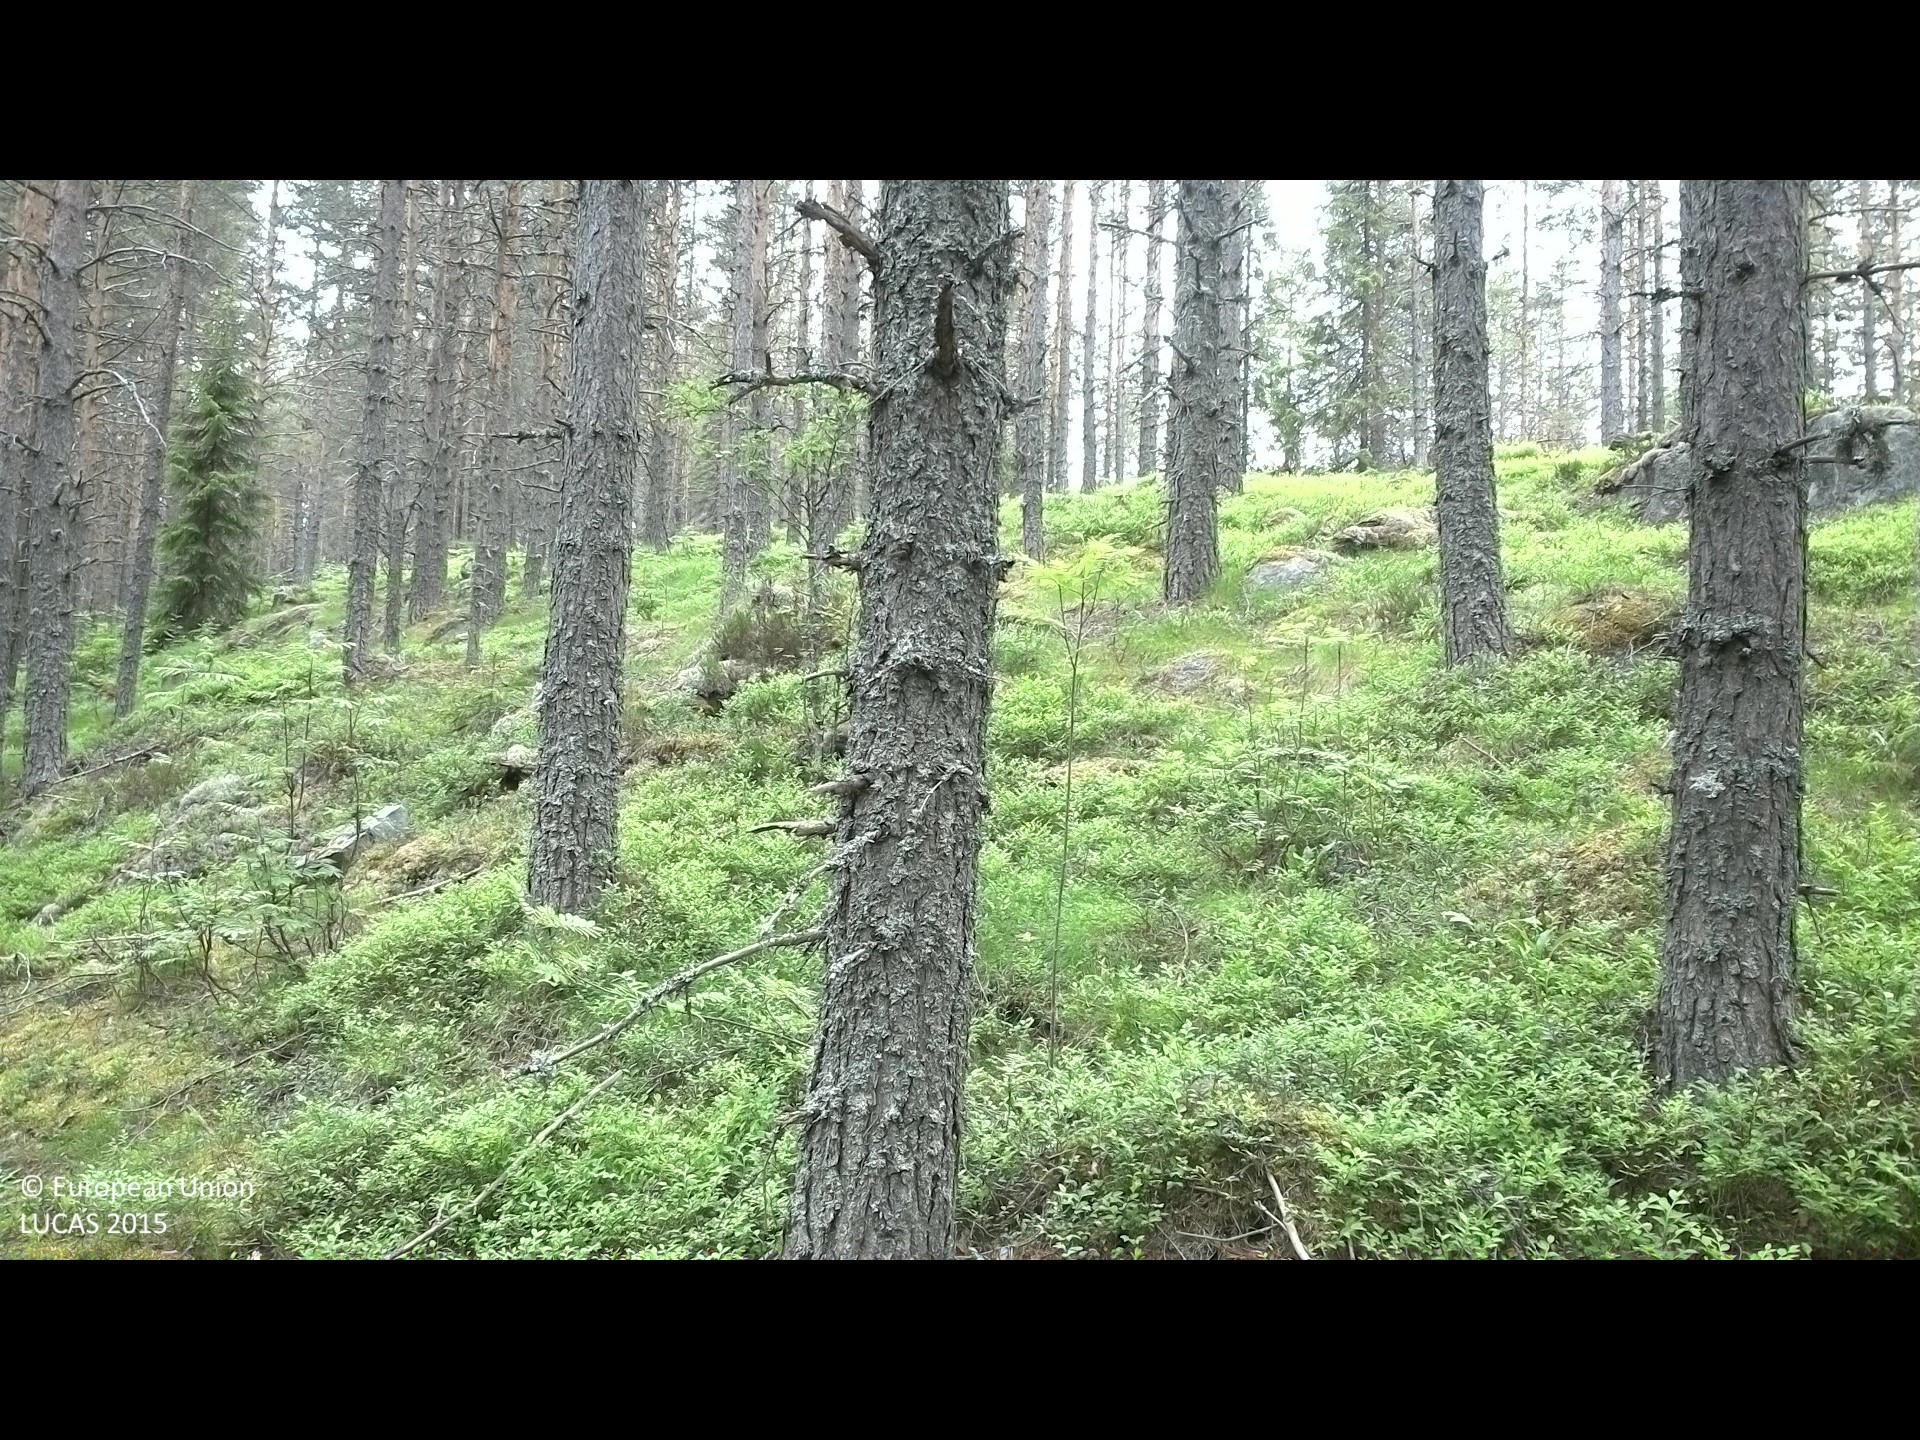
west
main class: Woodland
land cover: Pine dominated coniferous woodland
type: boreal forest
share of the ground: 50 - 75 %
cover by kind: coniferous forest trees 50 %, shrubs 30 %, lichens and mosses 20 %
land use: Forestry
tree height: > 5 m
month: June
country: SE
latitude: 62.0068
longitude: 16.3795
